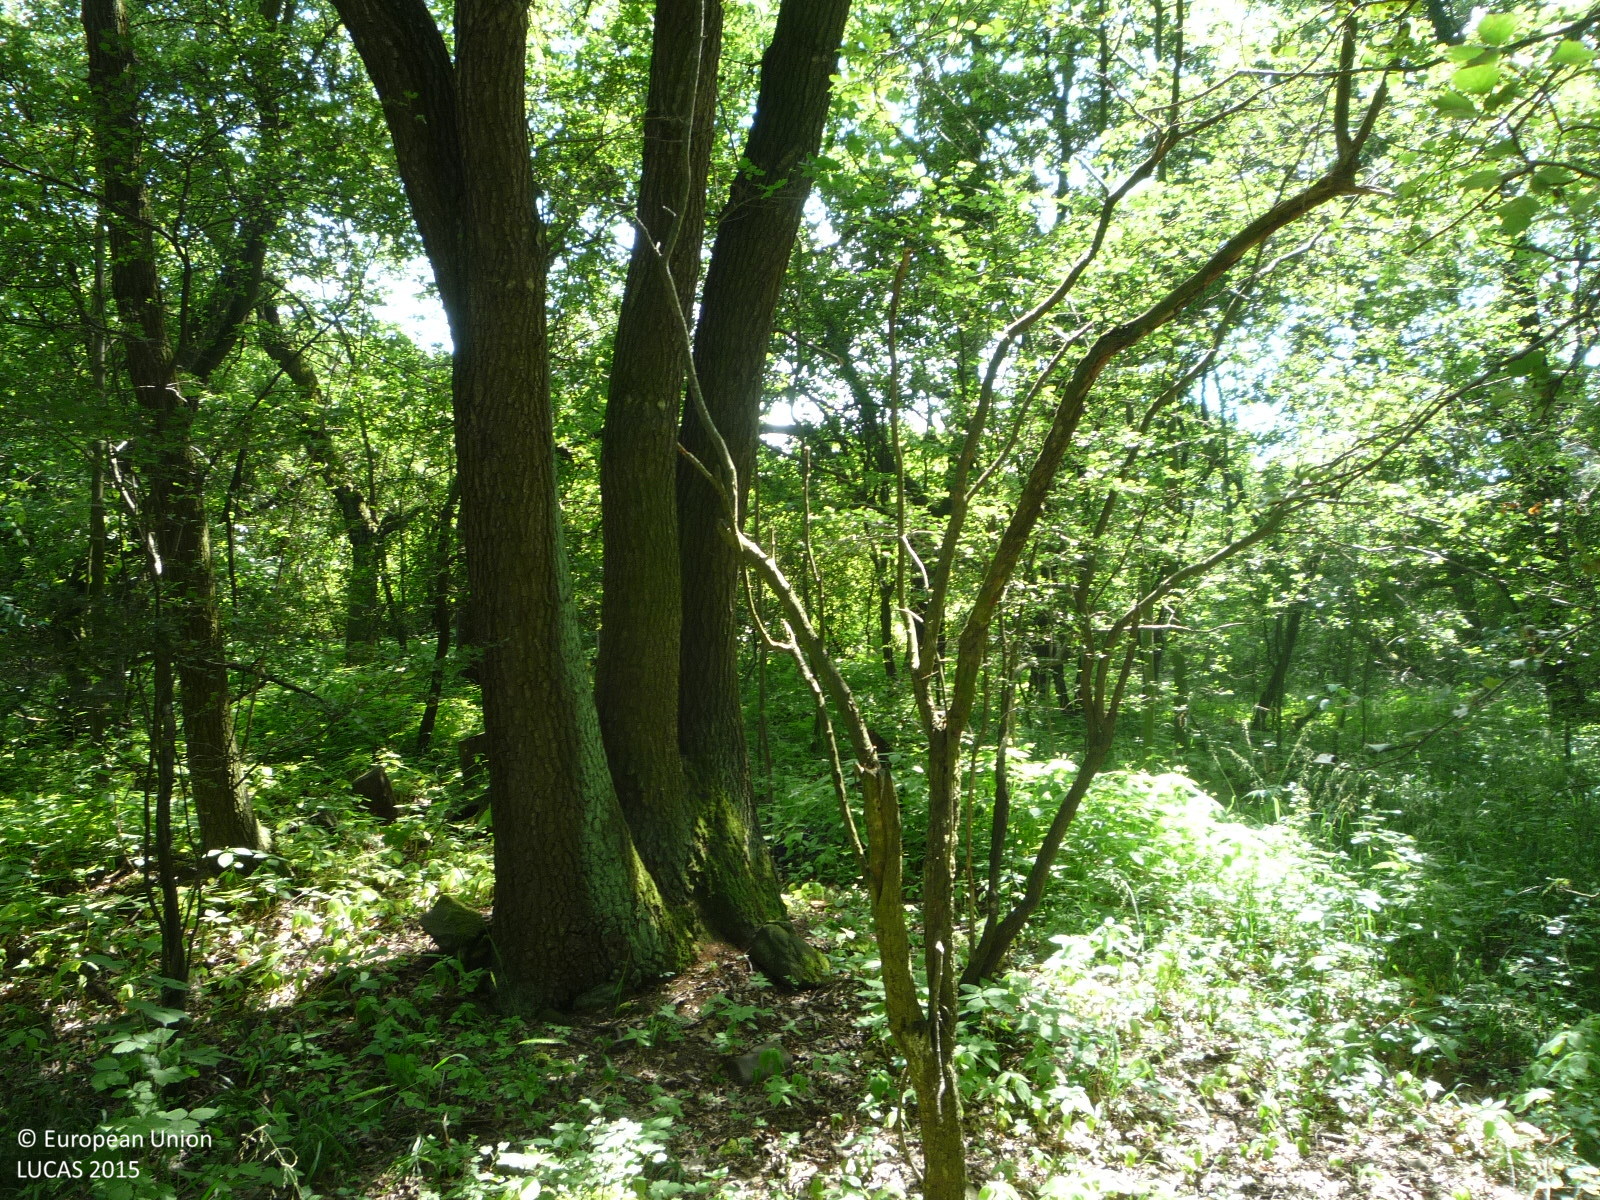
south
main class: Woodland
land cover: Broadleaved woodland
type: mesophytic deciduous forest
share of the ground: > 75 %
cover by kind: broadleaved forest trees 90 %, shrubs 5 %, herbaceous plants 5 %
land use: Forestry
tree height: > 5 m
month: July
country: CZ
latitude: 50.6002
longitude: 13.9993
